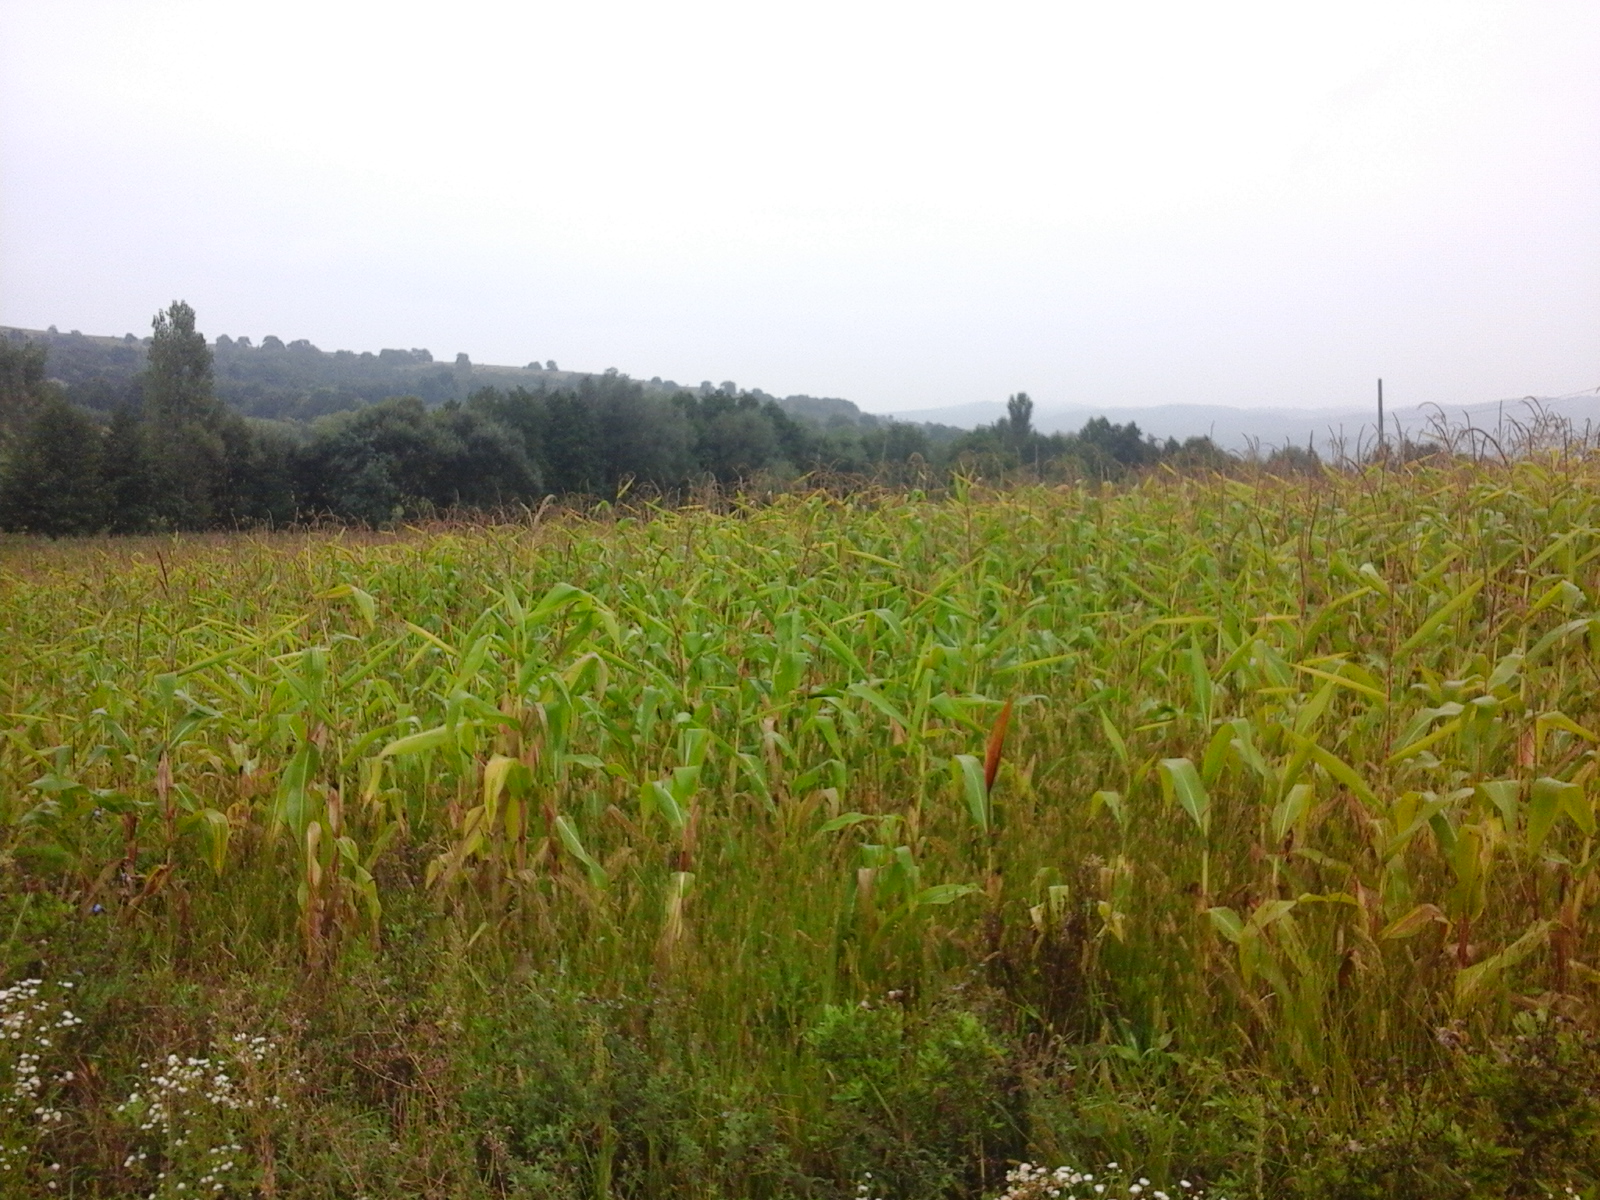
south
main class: Cropland
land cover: Other leguminous and mixtures for fodder
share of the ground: > 75 %
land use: Agriculture (excluding fallow land and kitchen gardens)
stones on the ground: < 10 %
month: September
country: RO
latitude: 47.1897
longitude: 22.5813
